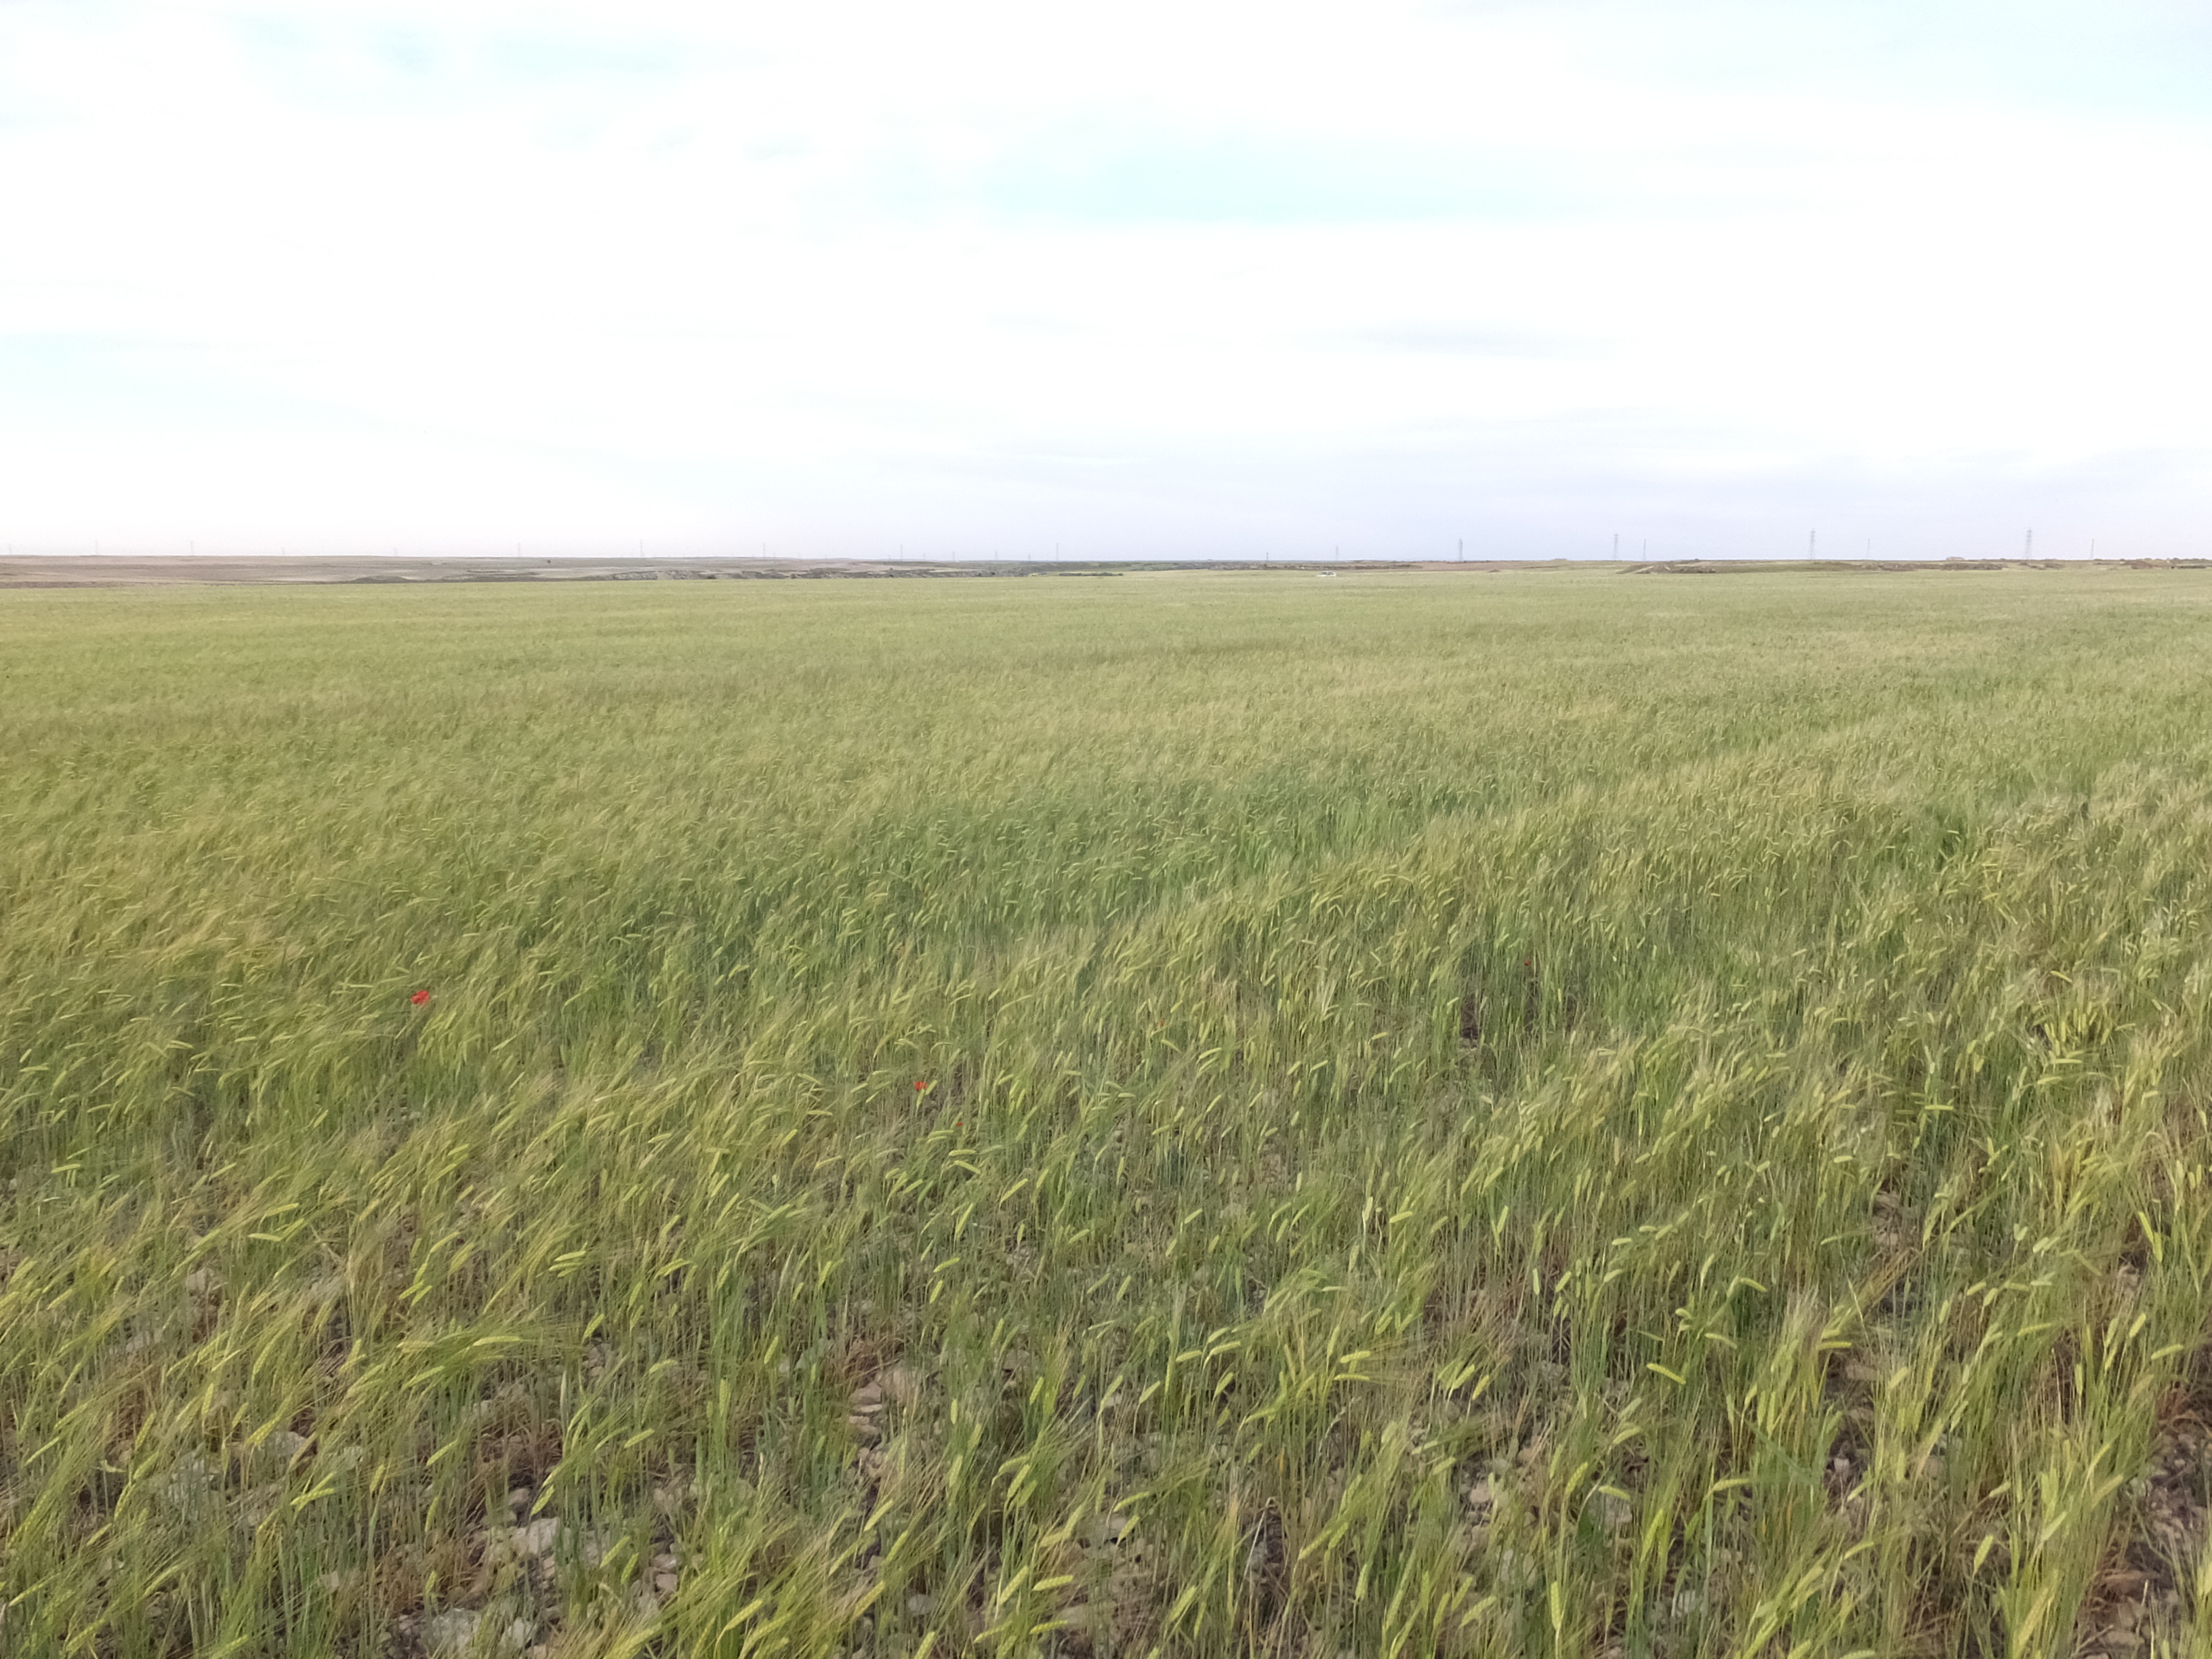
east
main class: Cropland
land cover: Barley
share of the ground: > 75 %
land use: Agriculture (excluding fallow land and kitchen gardens)
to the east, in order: Barley; Grass margins; Tracks; Grass margins; Barley
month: May
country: ES
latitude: 41.4104
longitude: -0.1955
